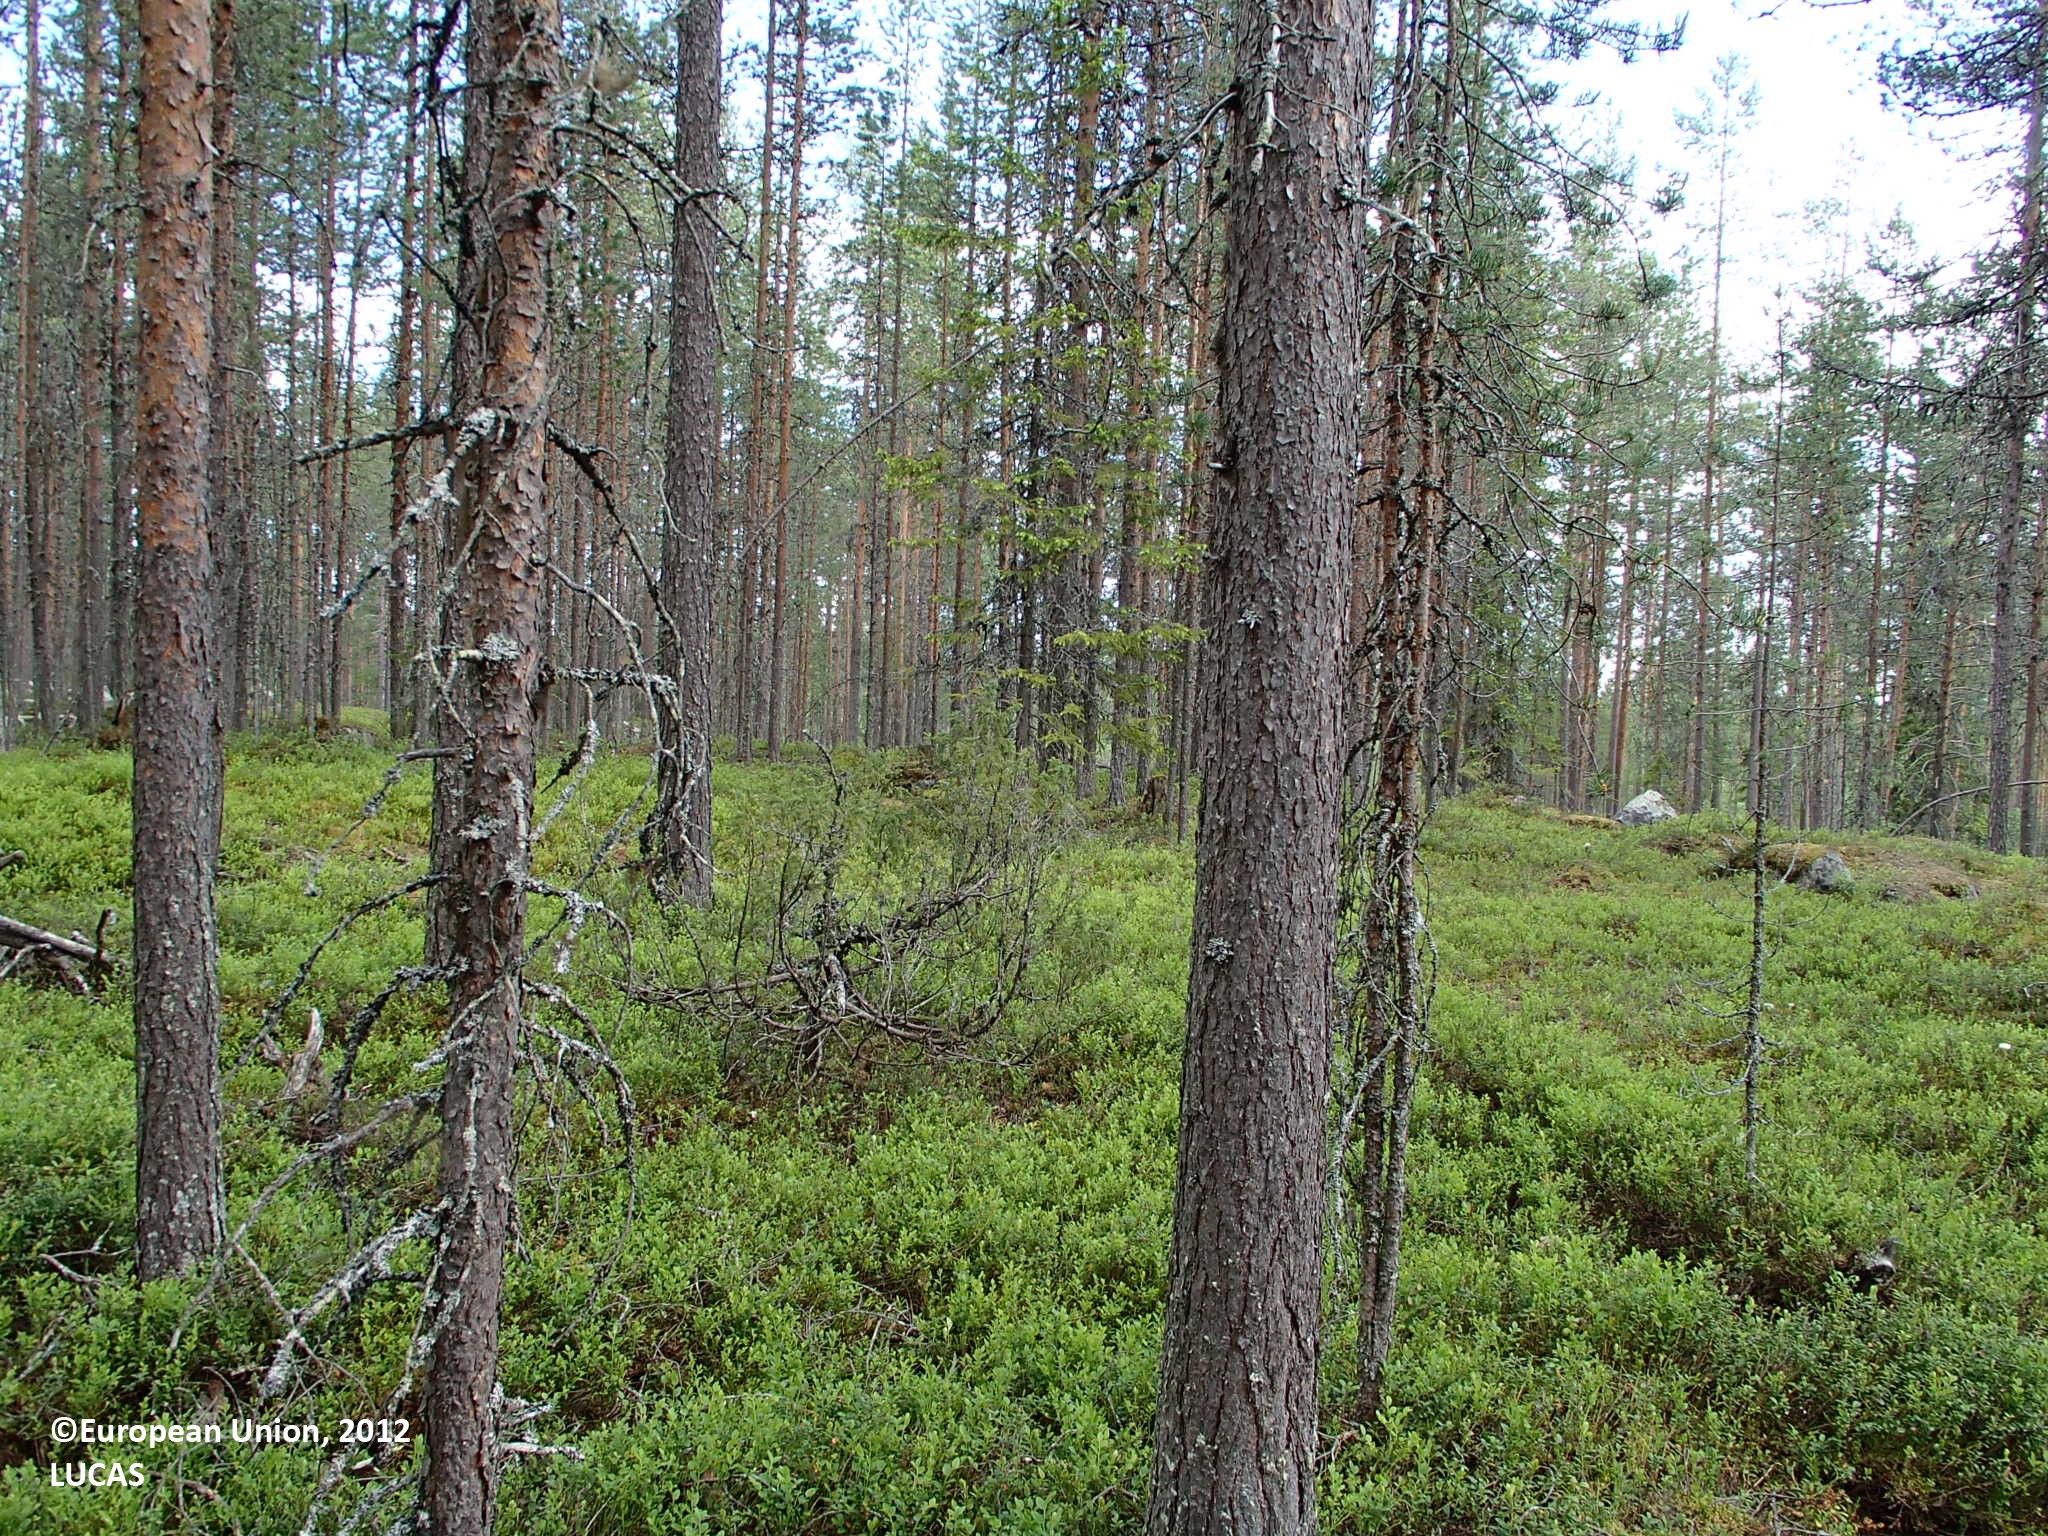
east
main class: Woodland
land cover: Pine dominated coniferous woodland
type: boreal forest
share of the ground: > 75 %
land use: Forestry
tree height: > 5 m
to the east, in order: Pine dominated coniferous woodland; Paved roads, cycling and walking lanes; Pine dominated coniferous woodland; Other bare soil
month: June
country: FI
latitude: 66.5785
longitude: 27.1701
